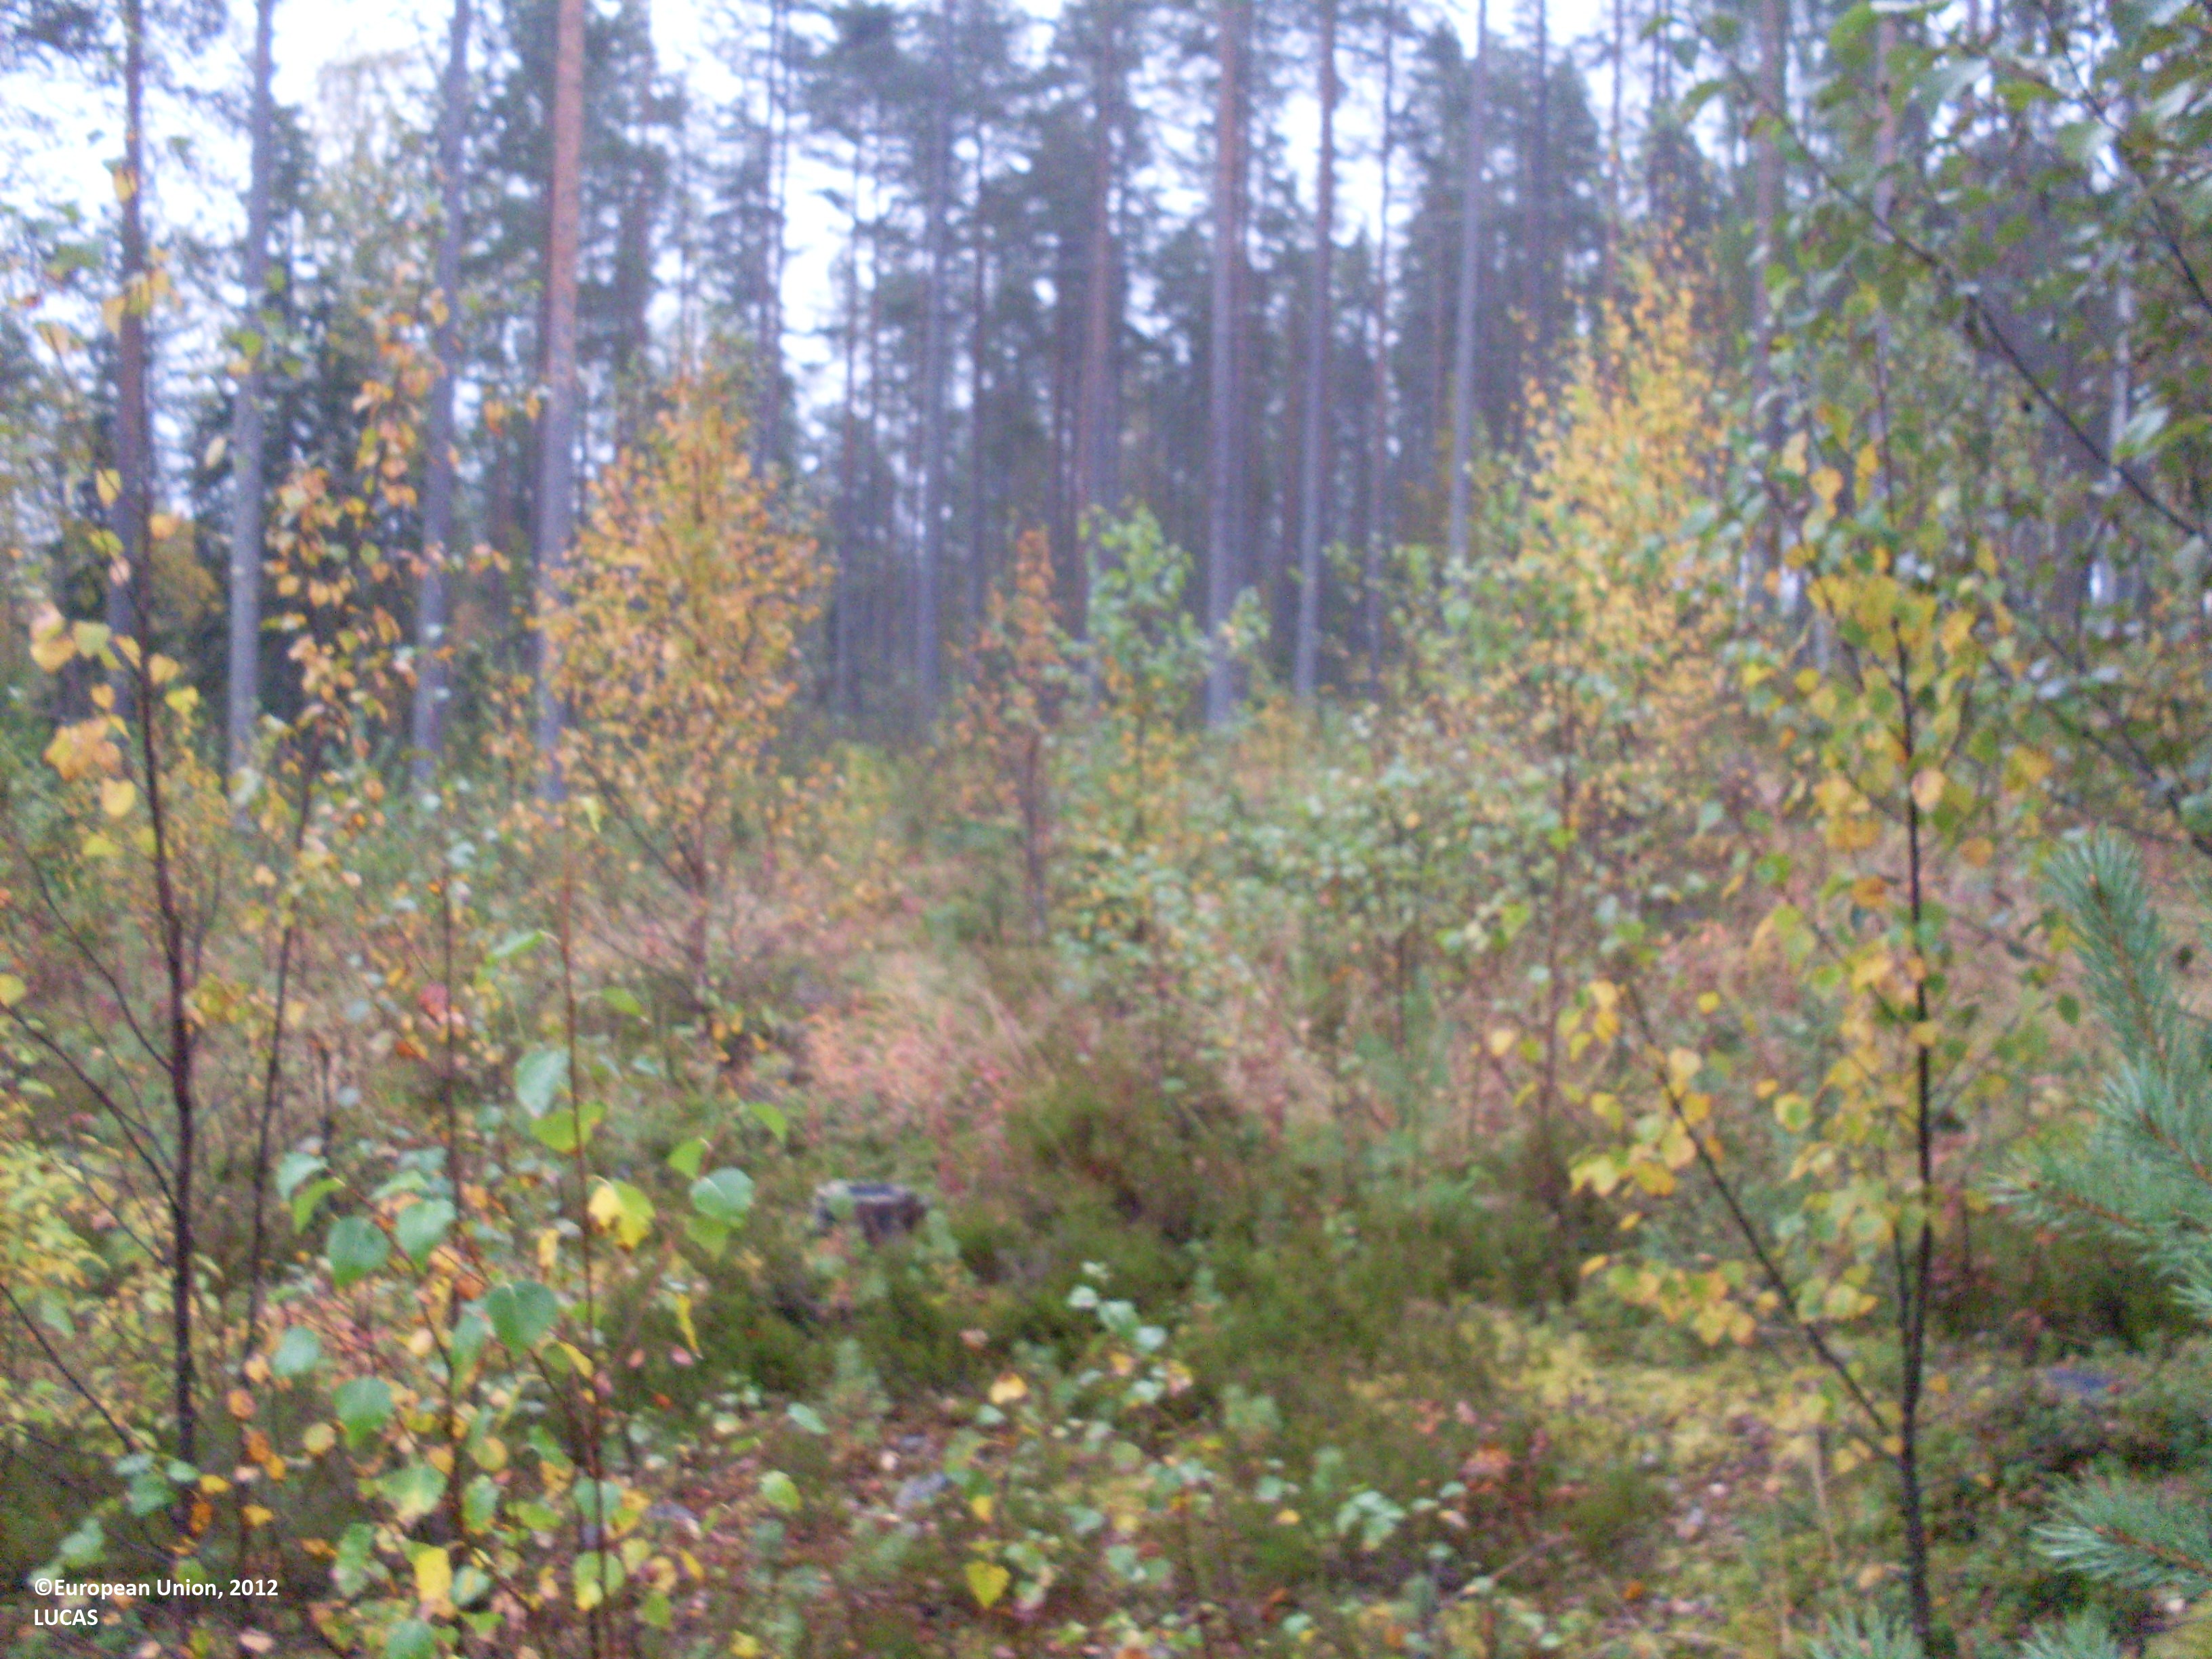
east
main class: Woodland
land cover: Pine dominated mixed woodland
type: boreal forest
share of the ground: 10 - 25 %
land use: Forestry
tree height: < 5 m
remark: Nursery
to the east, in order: Pine dominated mixed woodland; Electric lines; Pine dominated mixed woodland; Ditches and canals; Other mixed woodland
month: September
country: FI
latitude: 64.1670
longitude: 28.8489
